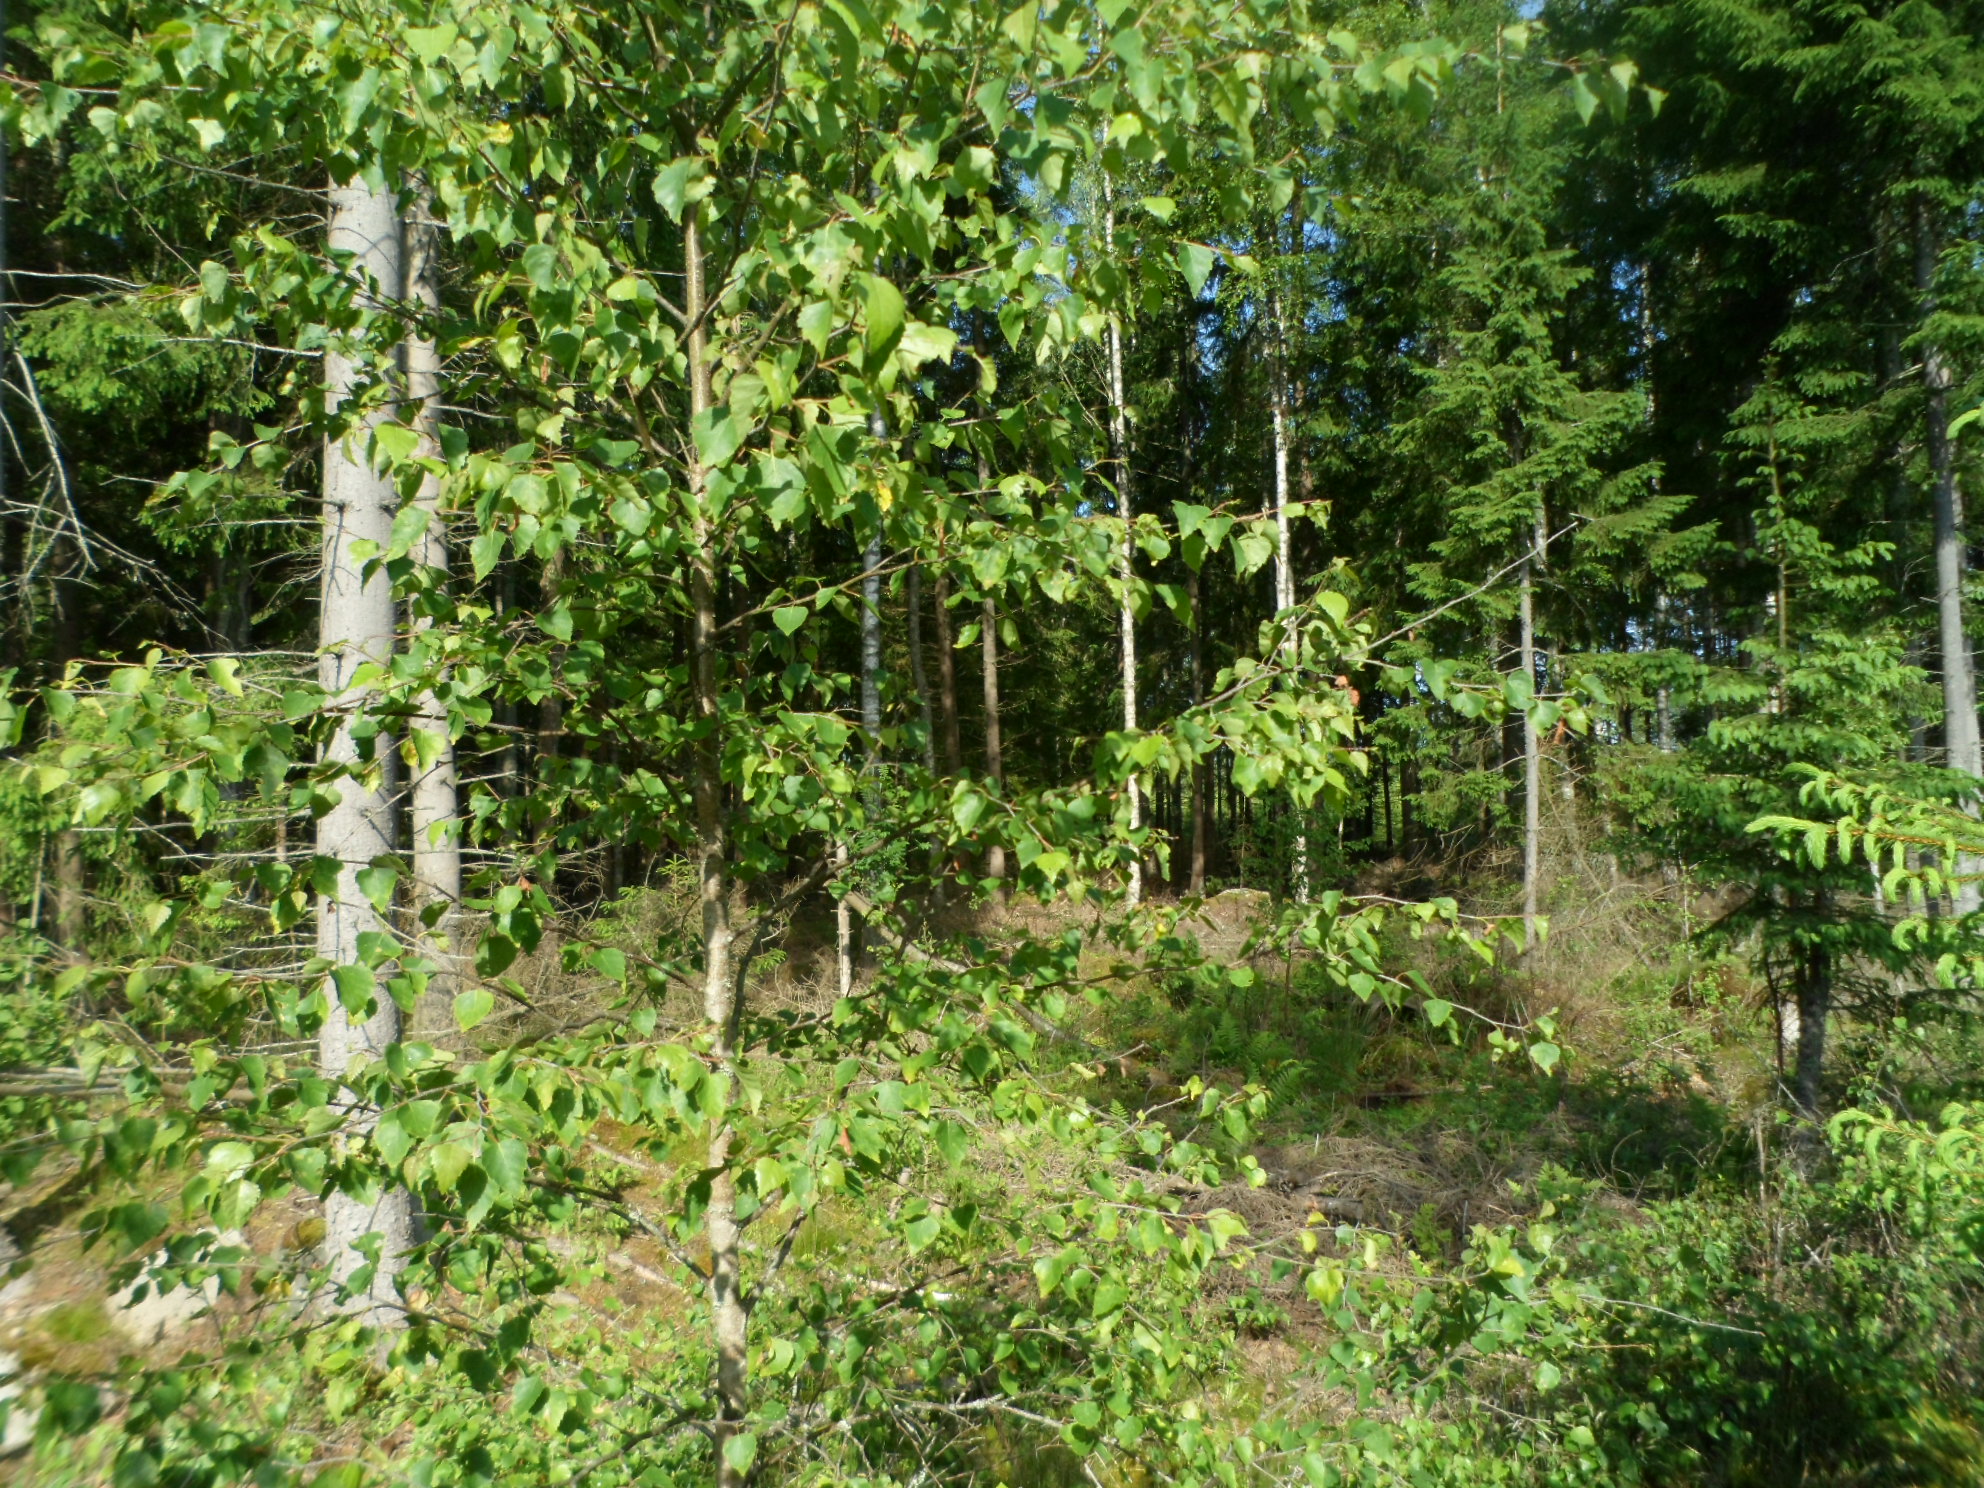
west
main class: Woodland
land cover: Spruce dominated mixed woodland
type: boreal forest
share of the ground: 50 - 75 %
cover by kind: coniferous forest trees 30 %, herbaceous plants 25 %, broadleaved forest trees 20 %, shrubs 20 %, lichens and mosses 5 %
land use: Forestry
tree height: < 5 m
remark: Clear cut
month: June
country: SE
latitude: 57.0852
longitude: 14.8975
